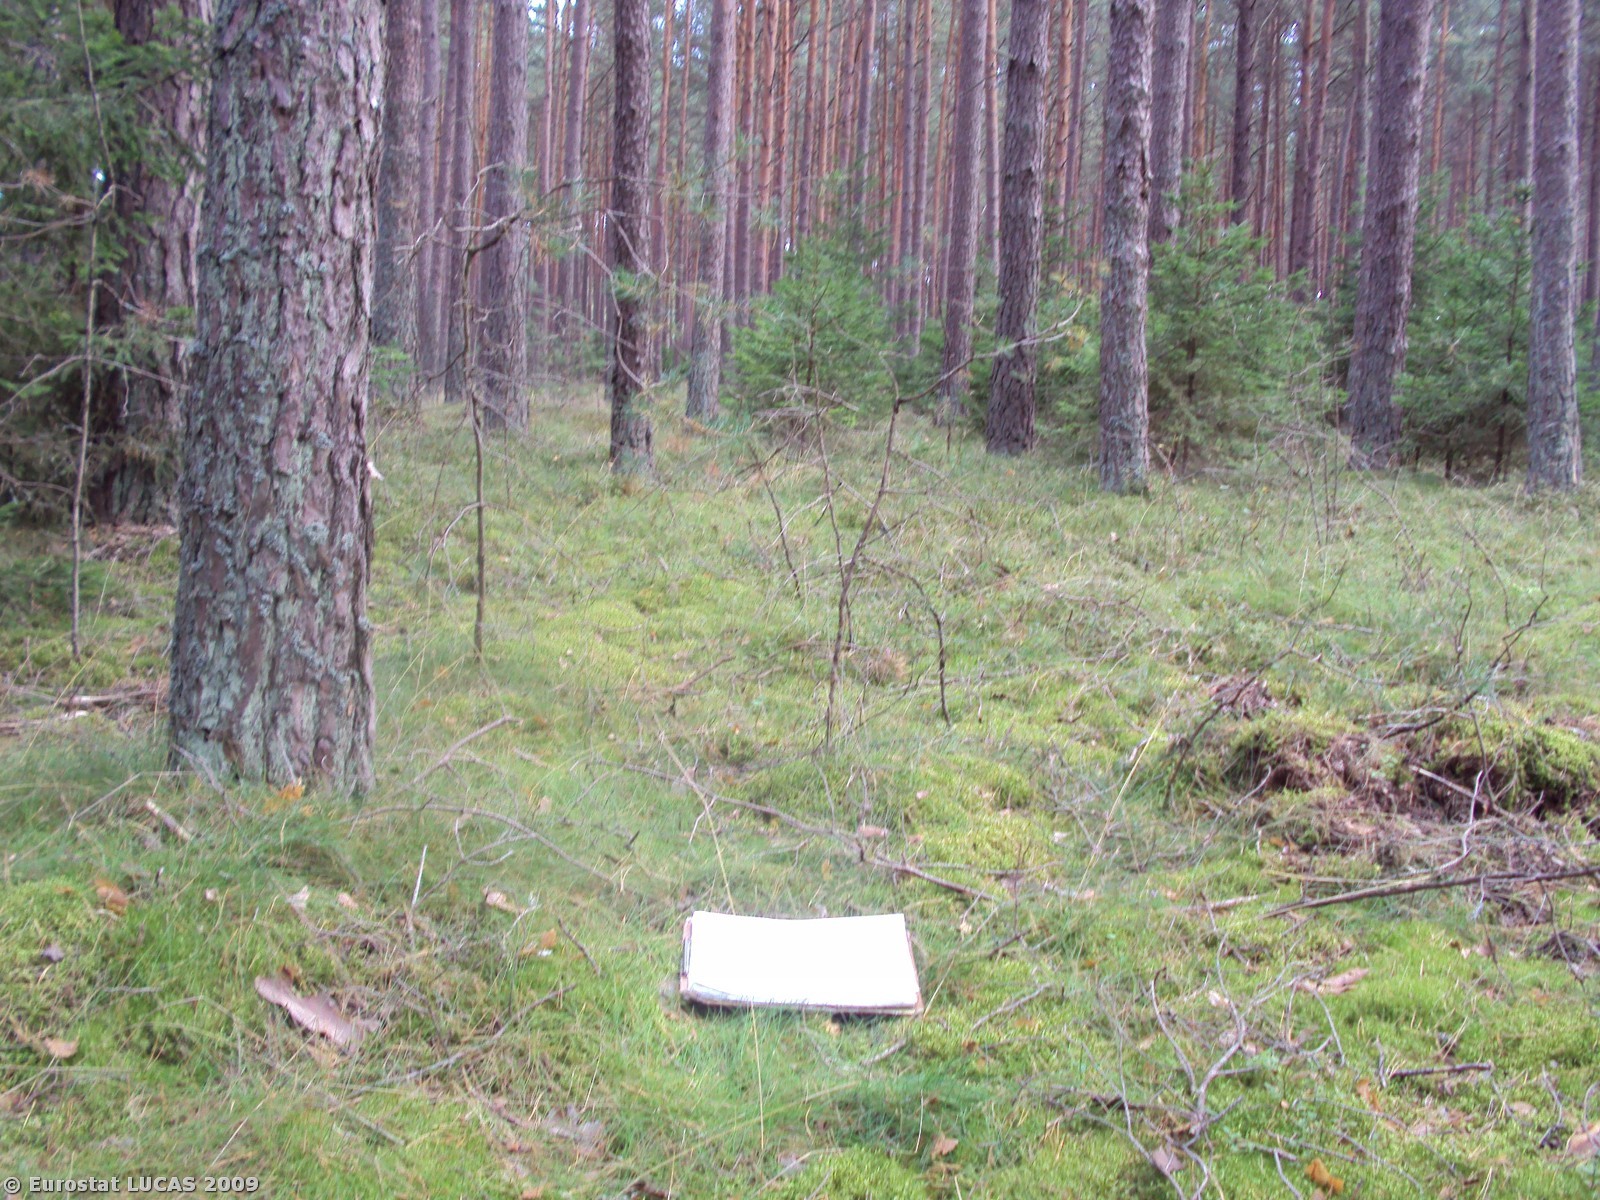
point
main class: Woodland
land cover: Coniferous woodland
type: hemiboreal forest and nemoral coniferous forest and mixed broadleaved-coniferous forest
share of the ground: > 75 %
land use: Forestry
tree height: > 5 m
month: September
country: PL
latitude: 53.3676
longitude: 16.5747
